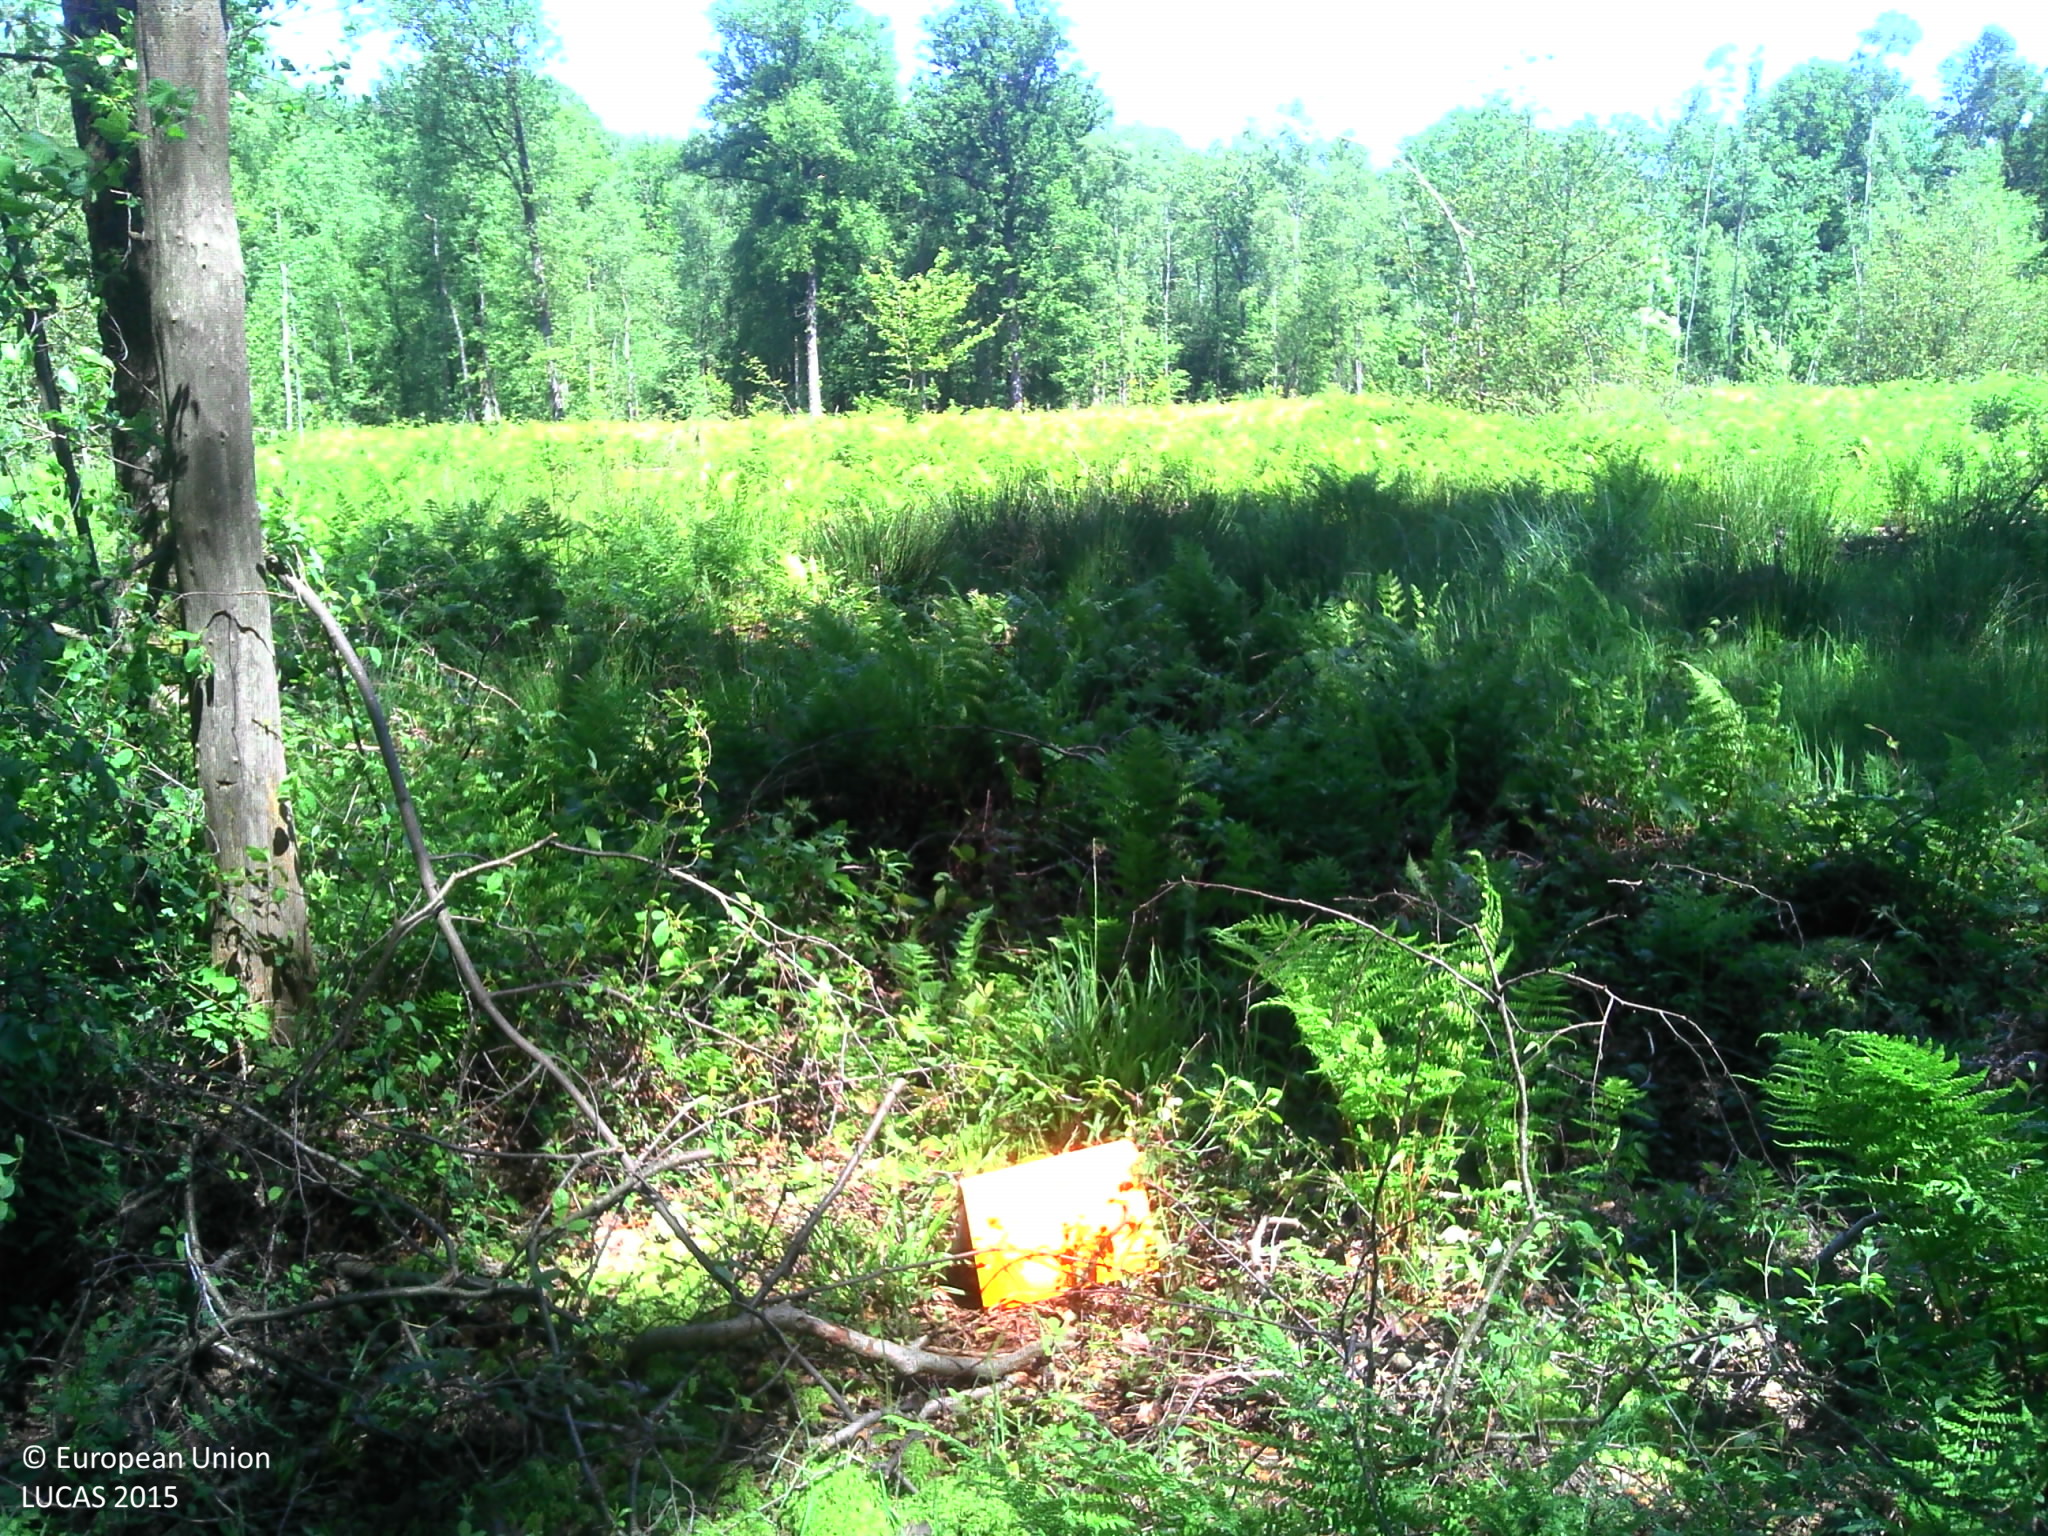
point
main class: Woodland
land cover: Broadleaved woodland
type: mesophytic deciduous forest
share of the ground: > 75 %
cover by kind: broadleaved forest trees 70 %, herbaceous plants 20 %, shrubs 10 %
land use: Forestry
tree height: > 5 m
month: June
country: FR
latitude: 49.9471
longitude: 4.2118
